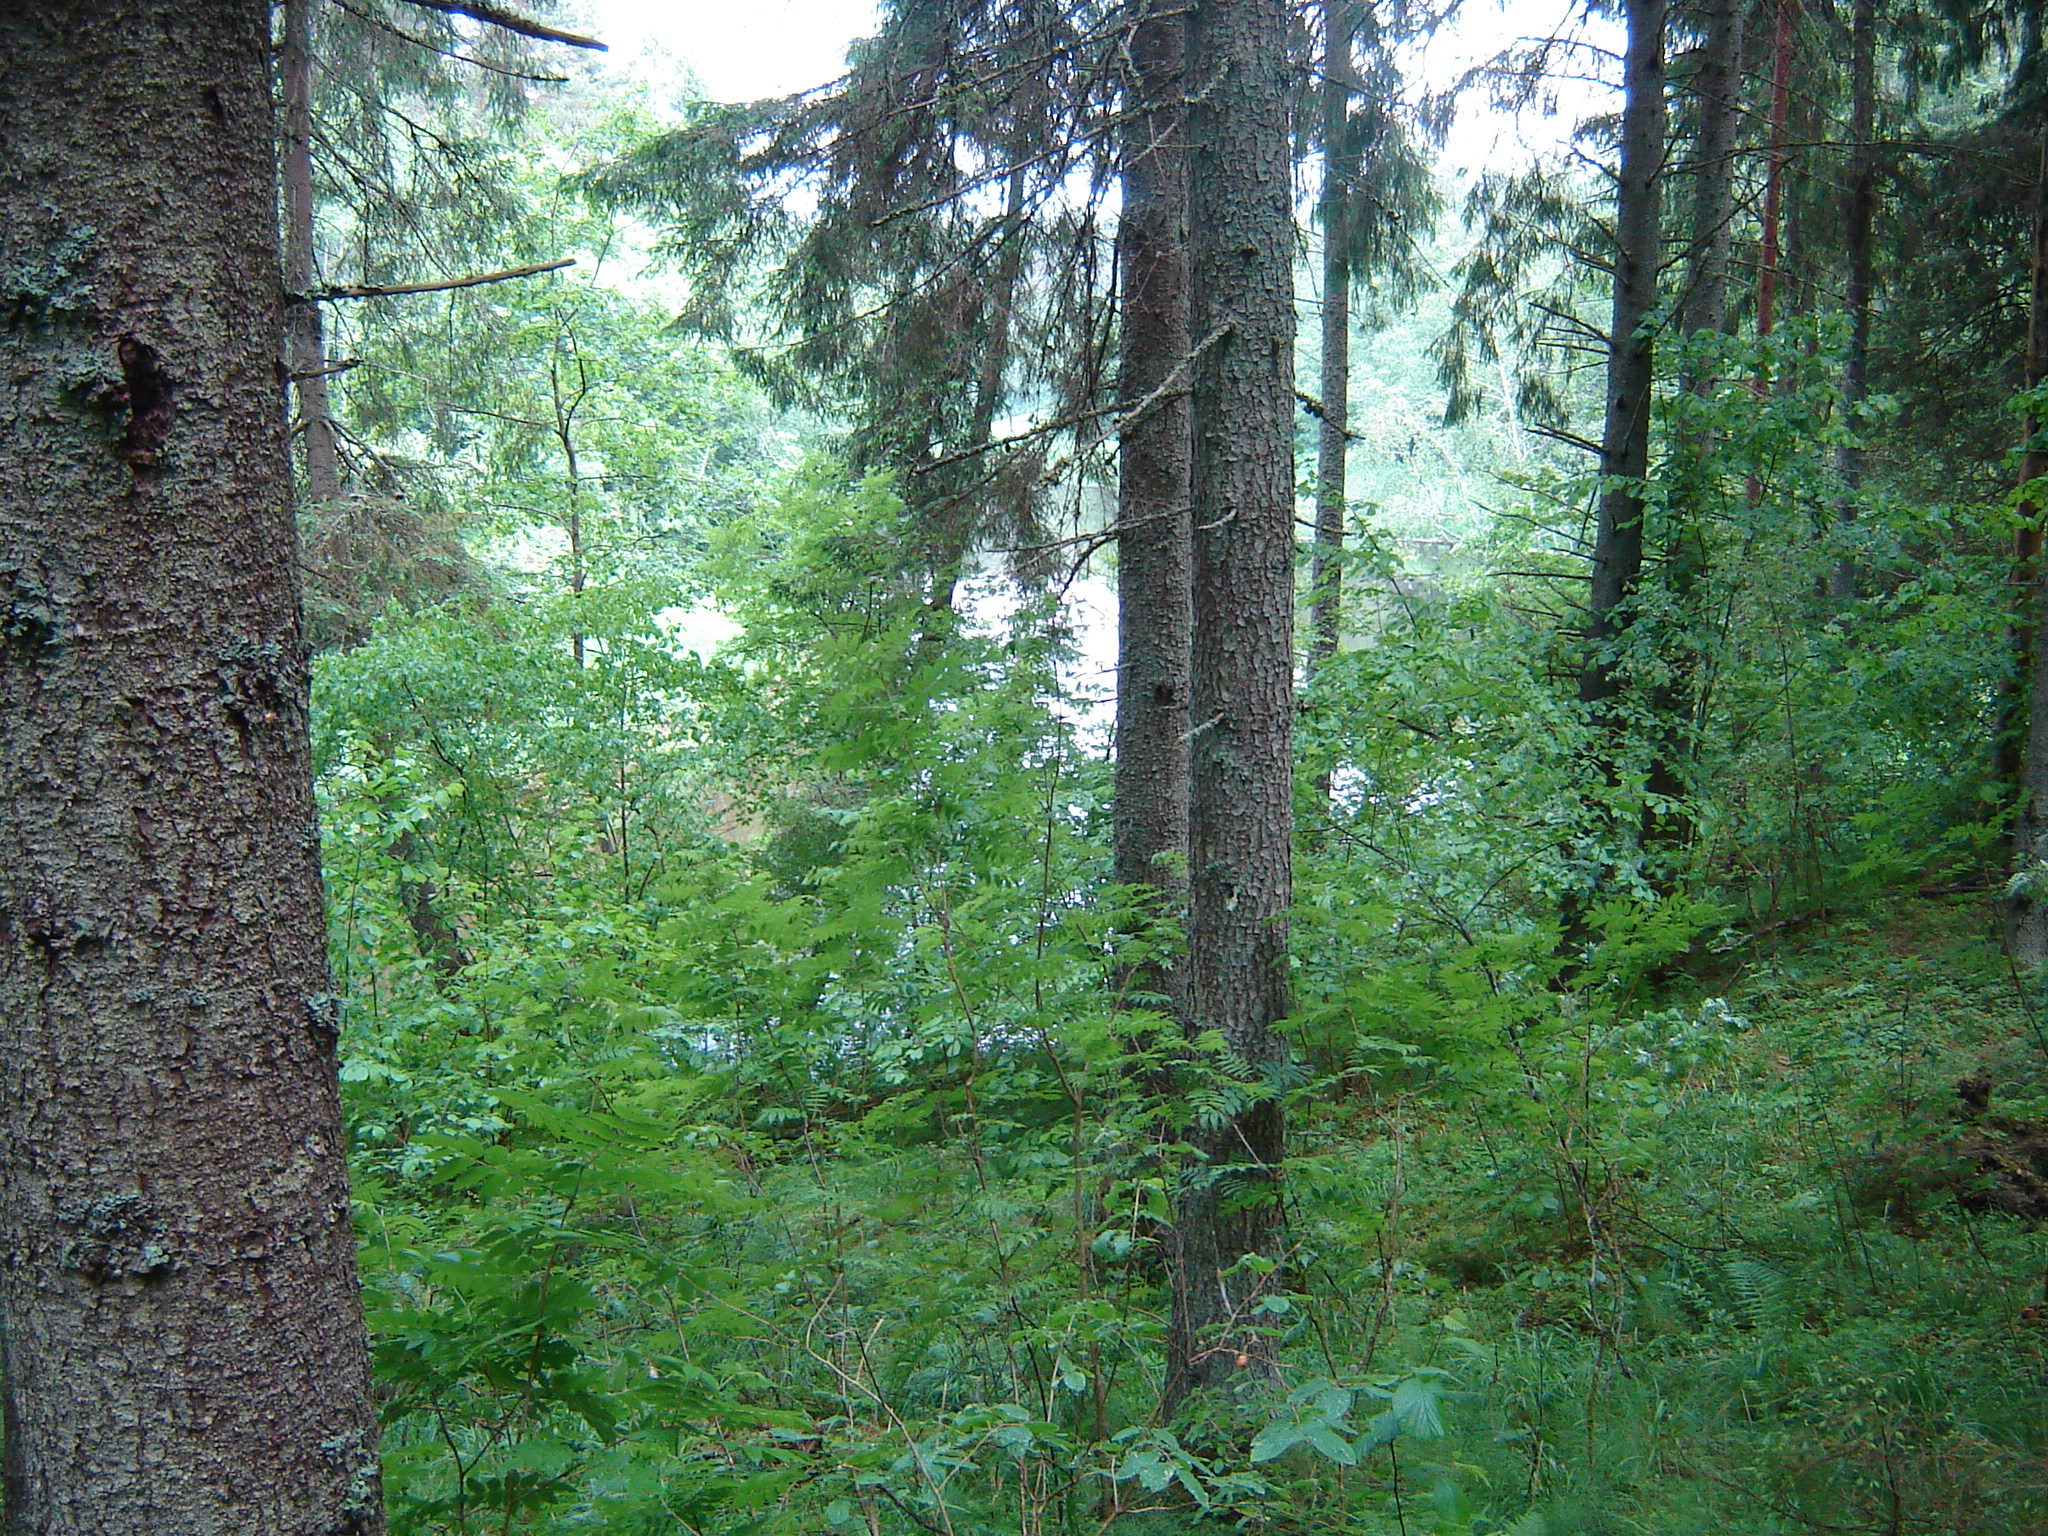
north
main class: Woodland
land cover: Spruce dominated coniferous woodland
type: hemiboreal forest and nemoral coniferous forest and mixed broadleaved-coniferous forest
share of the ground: > 75 %
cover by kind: coniferous forest trees 90 %, broadleaved forest trees 10 %
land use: Forestry
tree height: > 5 m
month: June
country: LT
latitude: 55.6594
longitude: 25.2006
